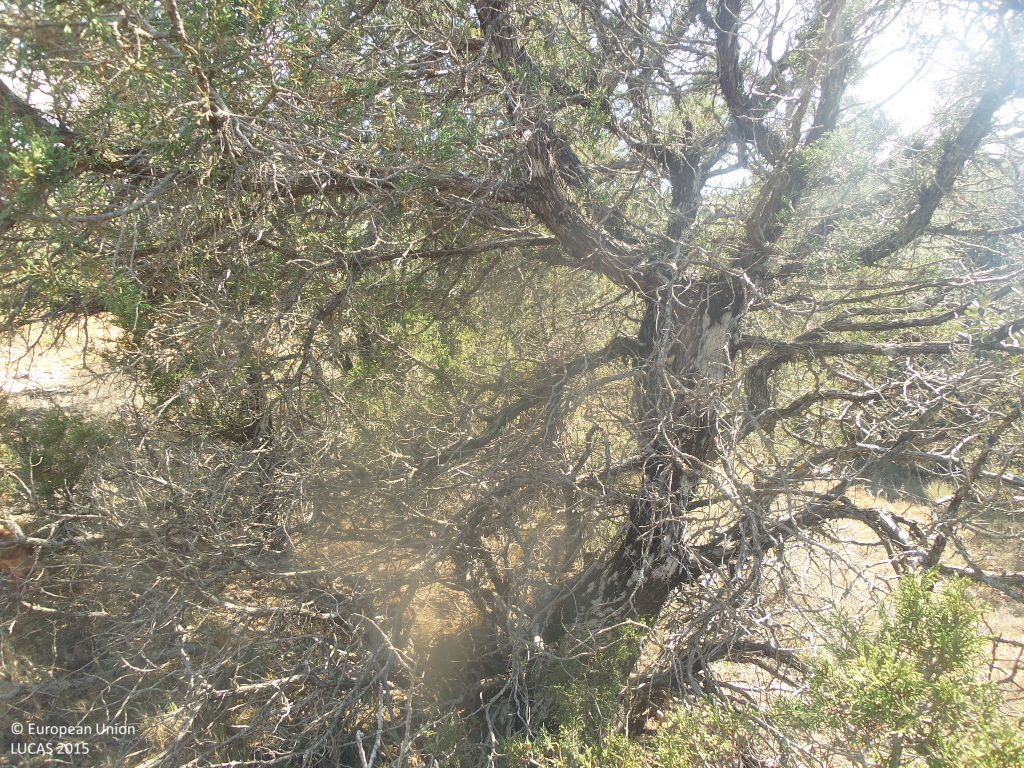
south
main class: Woodland
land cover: Other mixed woodland
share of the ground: 50 - 75 %
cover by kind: coniferous forest trees 40 %, broadleaved forest trees 20 %, shrubs 20 %, herbaceous plants 10 %, unconsolidated bare surface 10 %
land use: Semi-natural and natural areas not in use
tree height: < 5 m
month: July
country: ES
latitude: 41.1594
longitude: -2.0998
